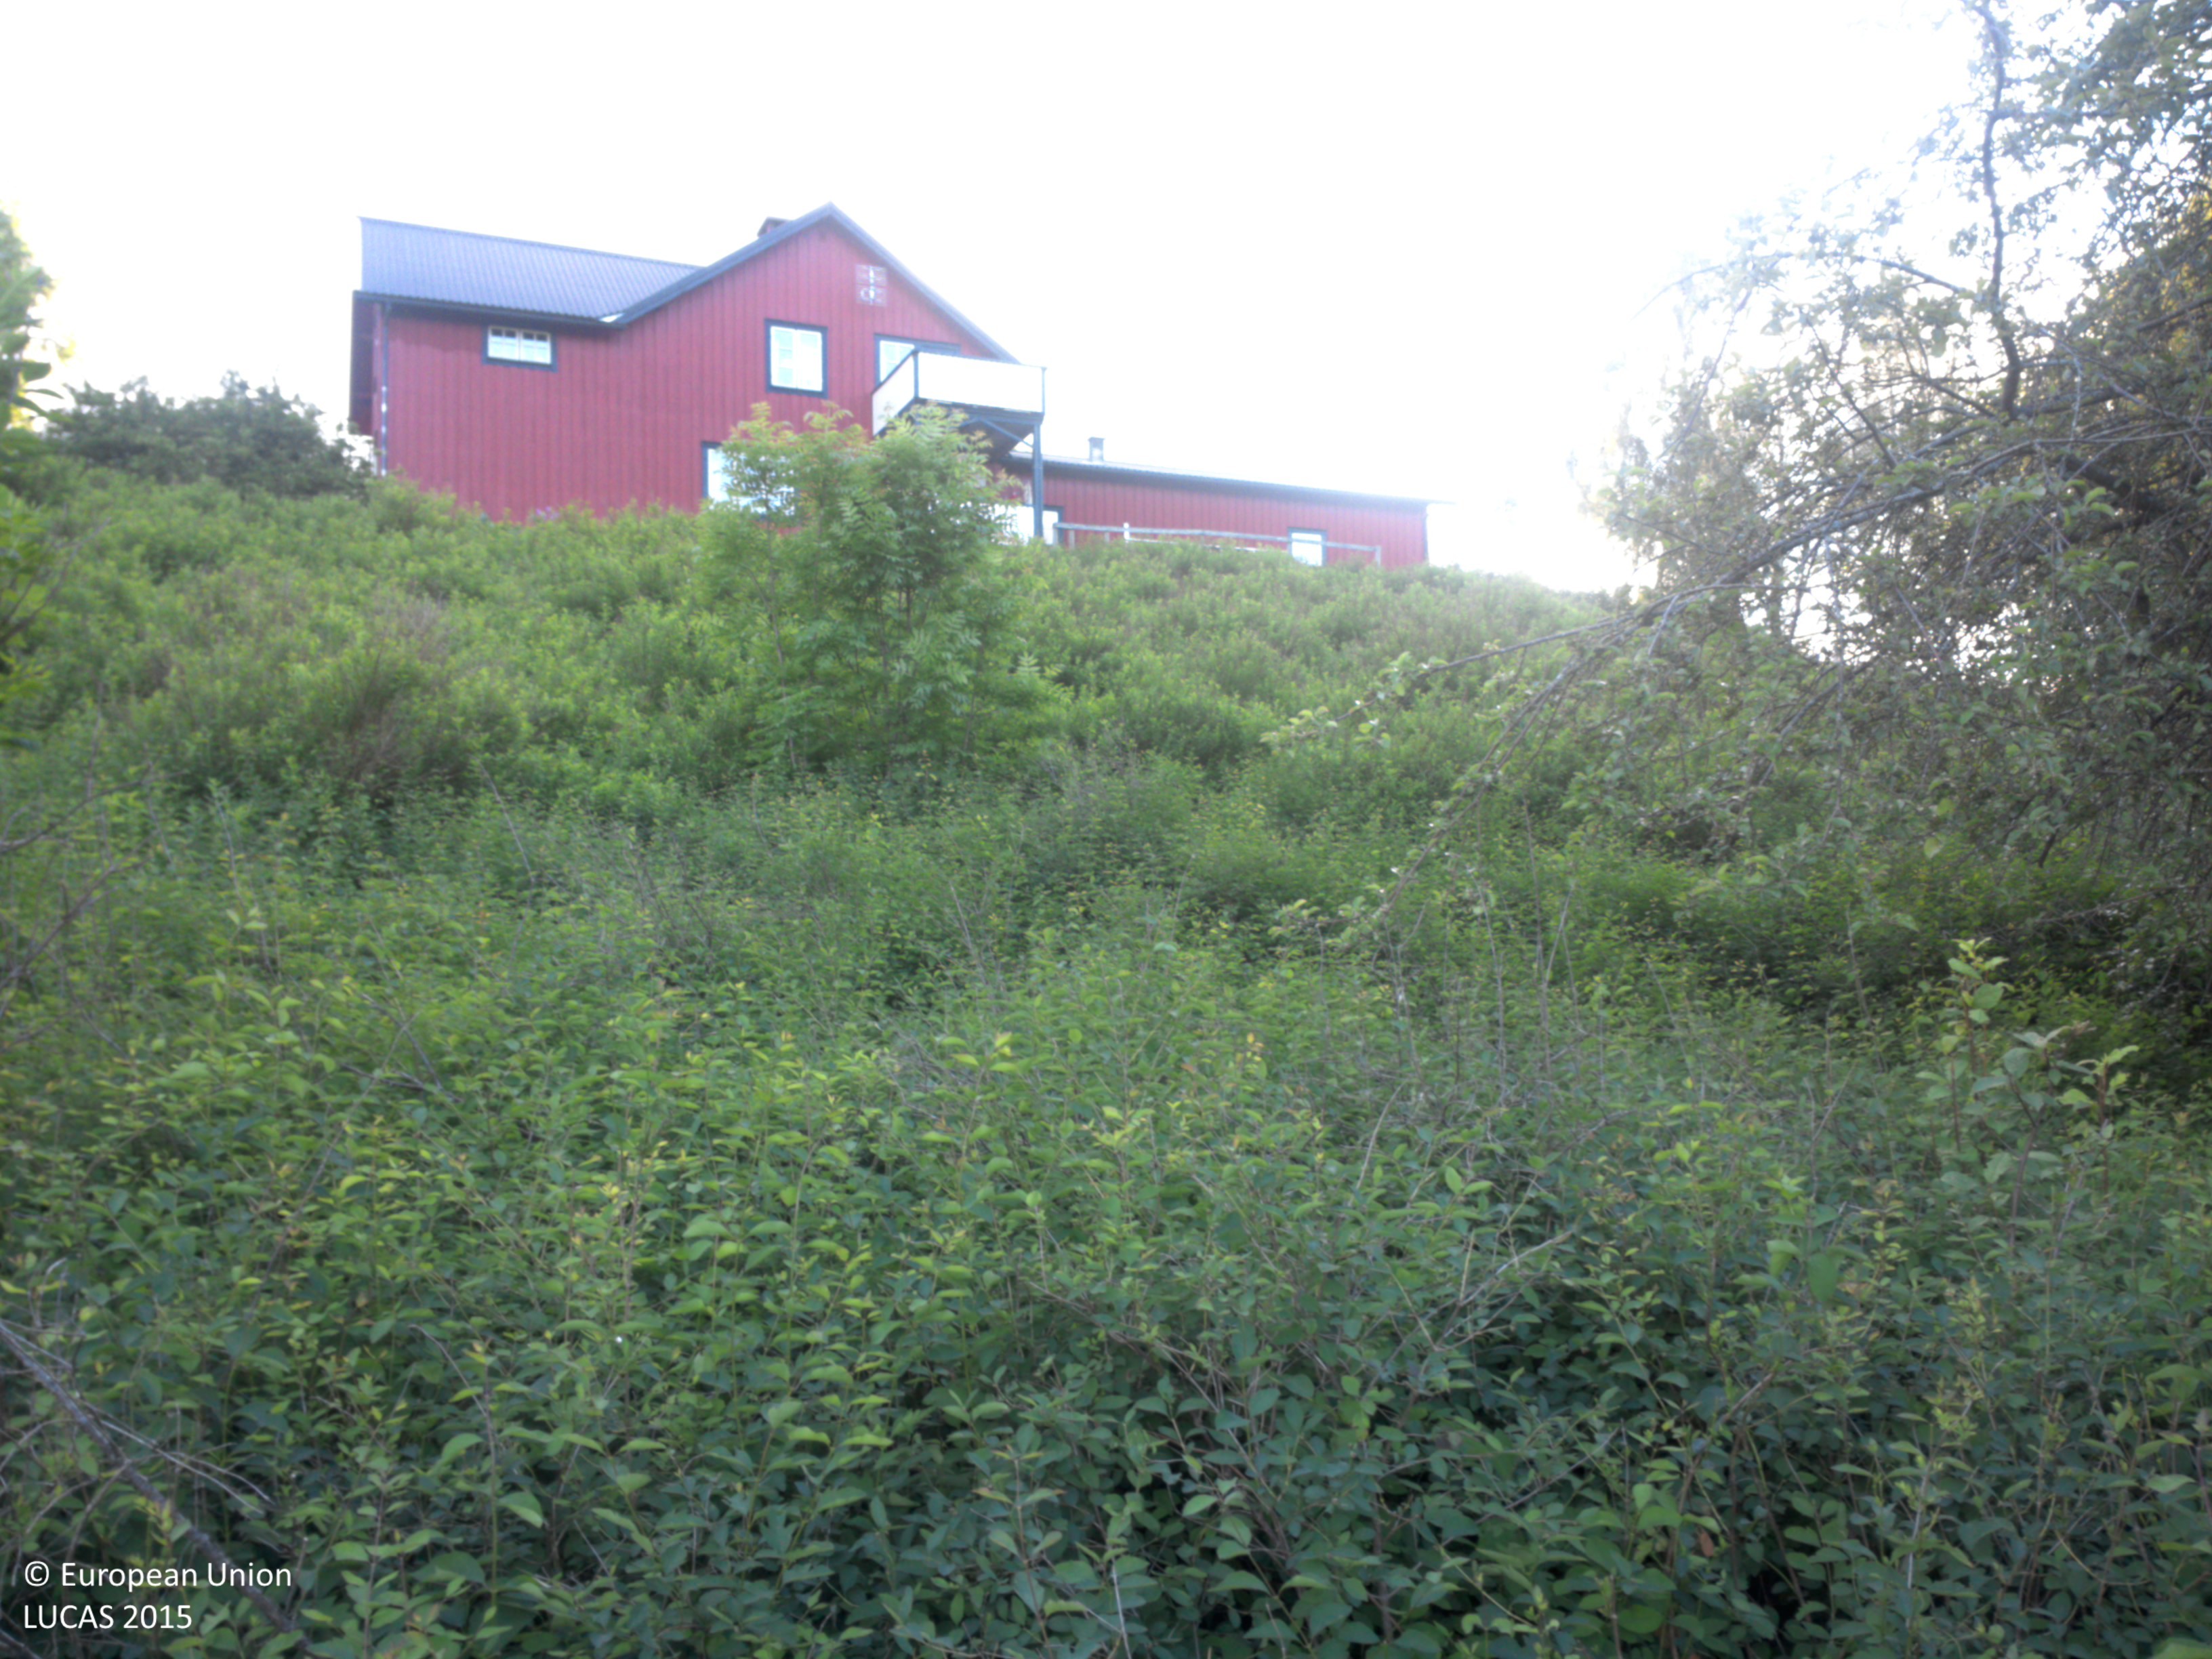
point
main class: Shrubland
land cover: Shrubland with sparse tree cover
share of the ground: > 75 %
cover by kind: shrubs 95 %, broadleaved forest trees 5 %
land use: Residential
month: June
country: SE
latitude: 58.8900
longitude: 11.8870
